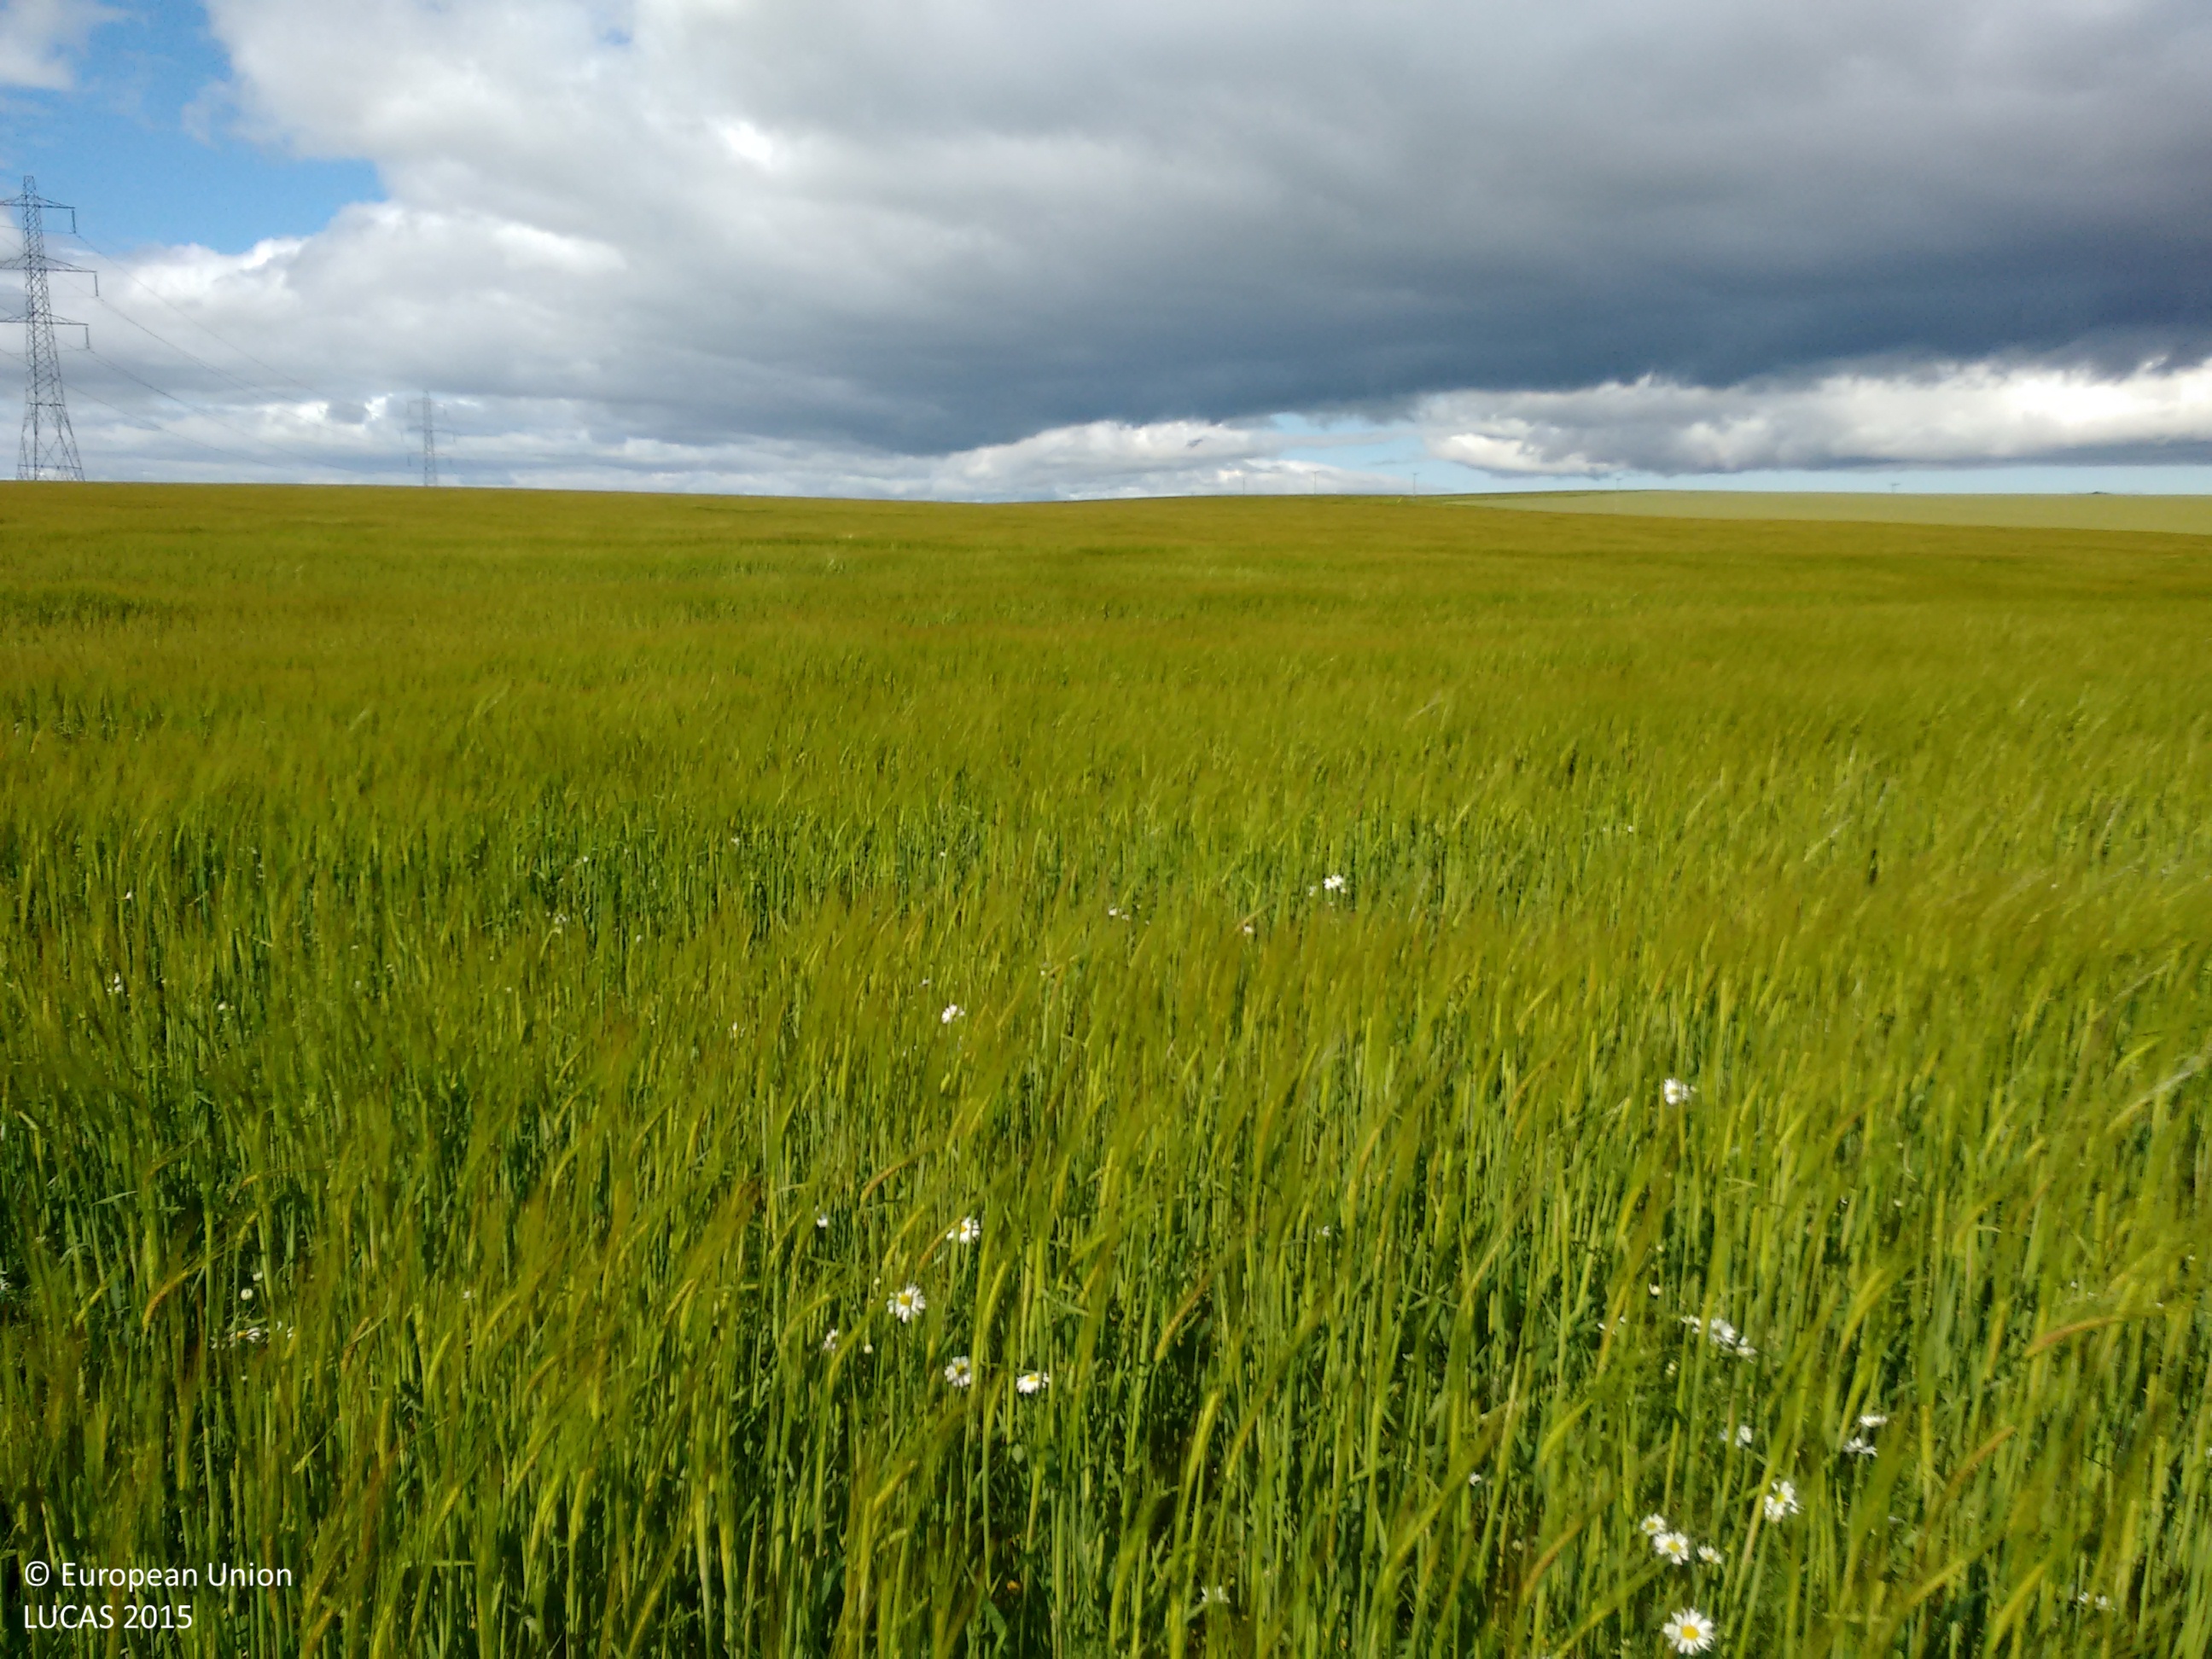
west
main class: Cropland
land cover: Barley
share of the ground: > 75 %
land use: Agriculture (excluding fallow land and kitchen gardens)
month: July
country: GB
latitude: 57.4849
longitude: -1.9373
